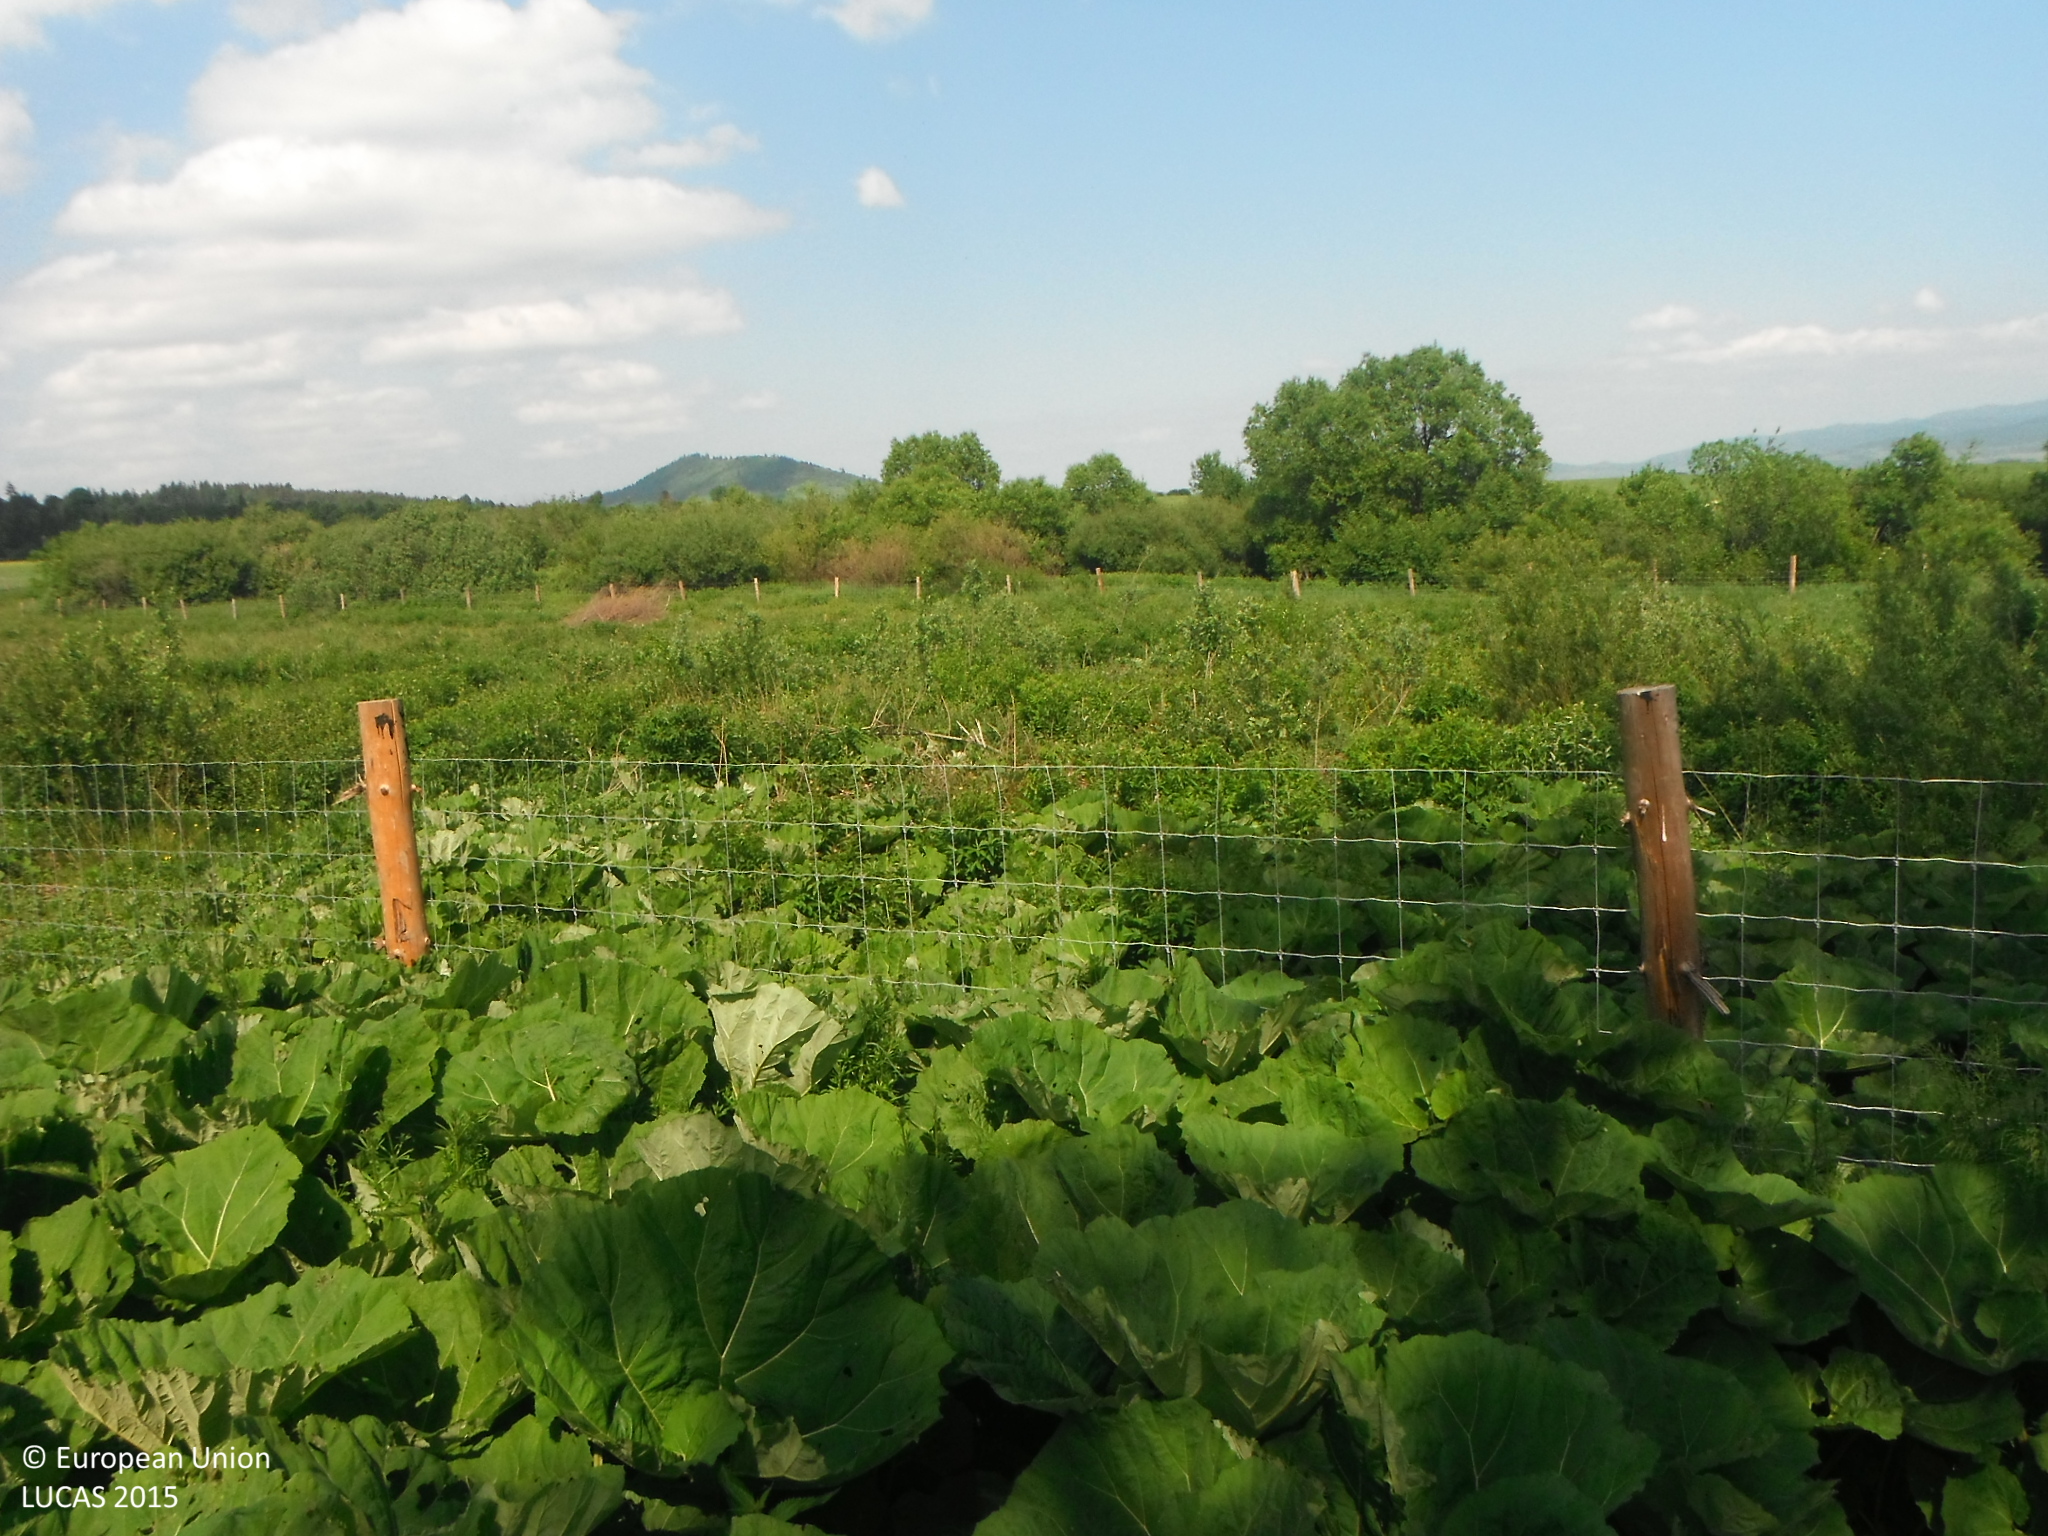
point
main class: Grassland
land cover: Spontaneously vegetated surfaces
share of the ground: > 75 %
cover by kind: herbaceous plants 100 %
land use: Fallow land
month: June
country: SK
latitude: 49.2354
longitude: 20.4045
